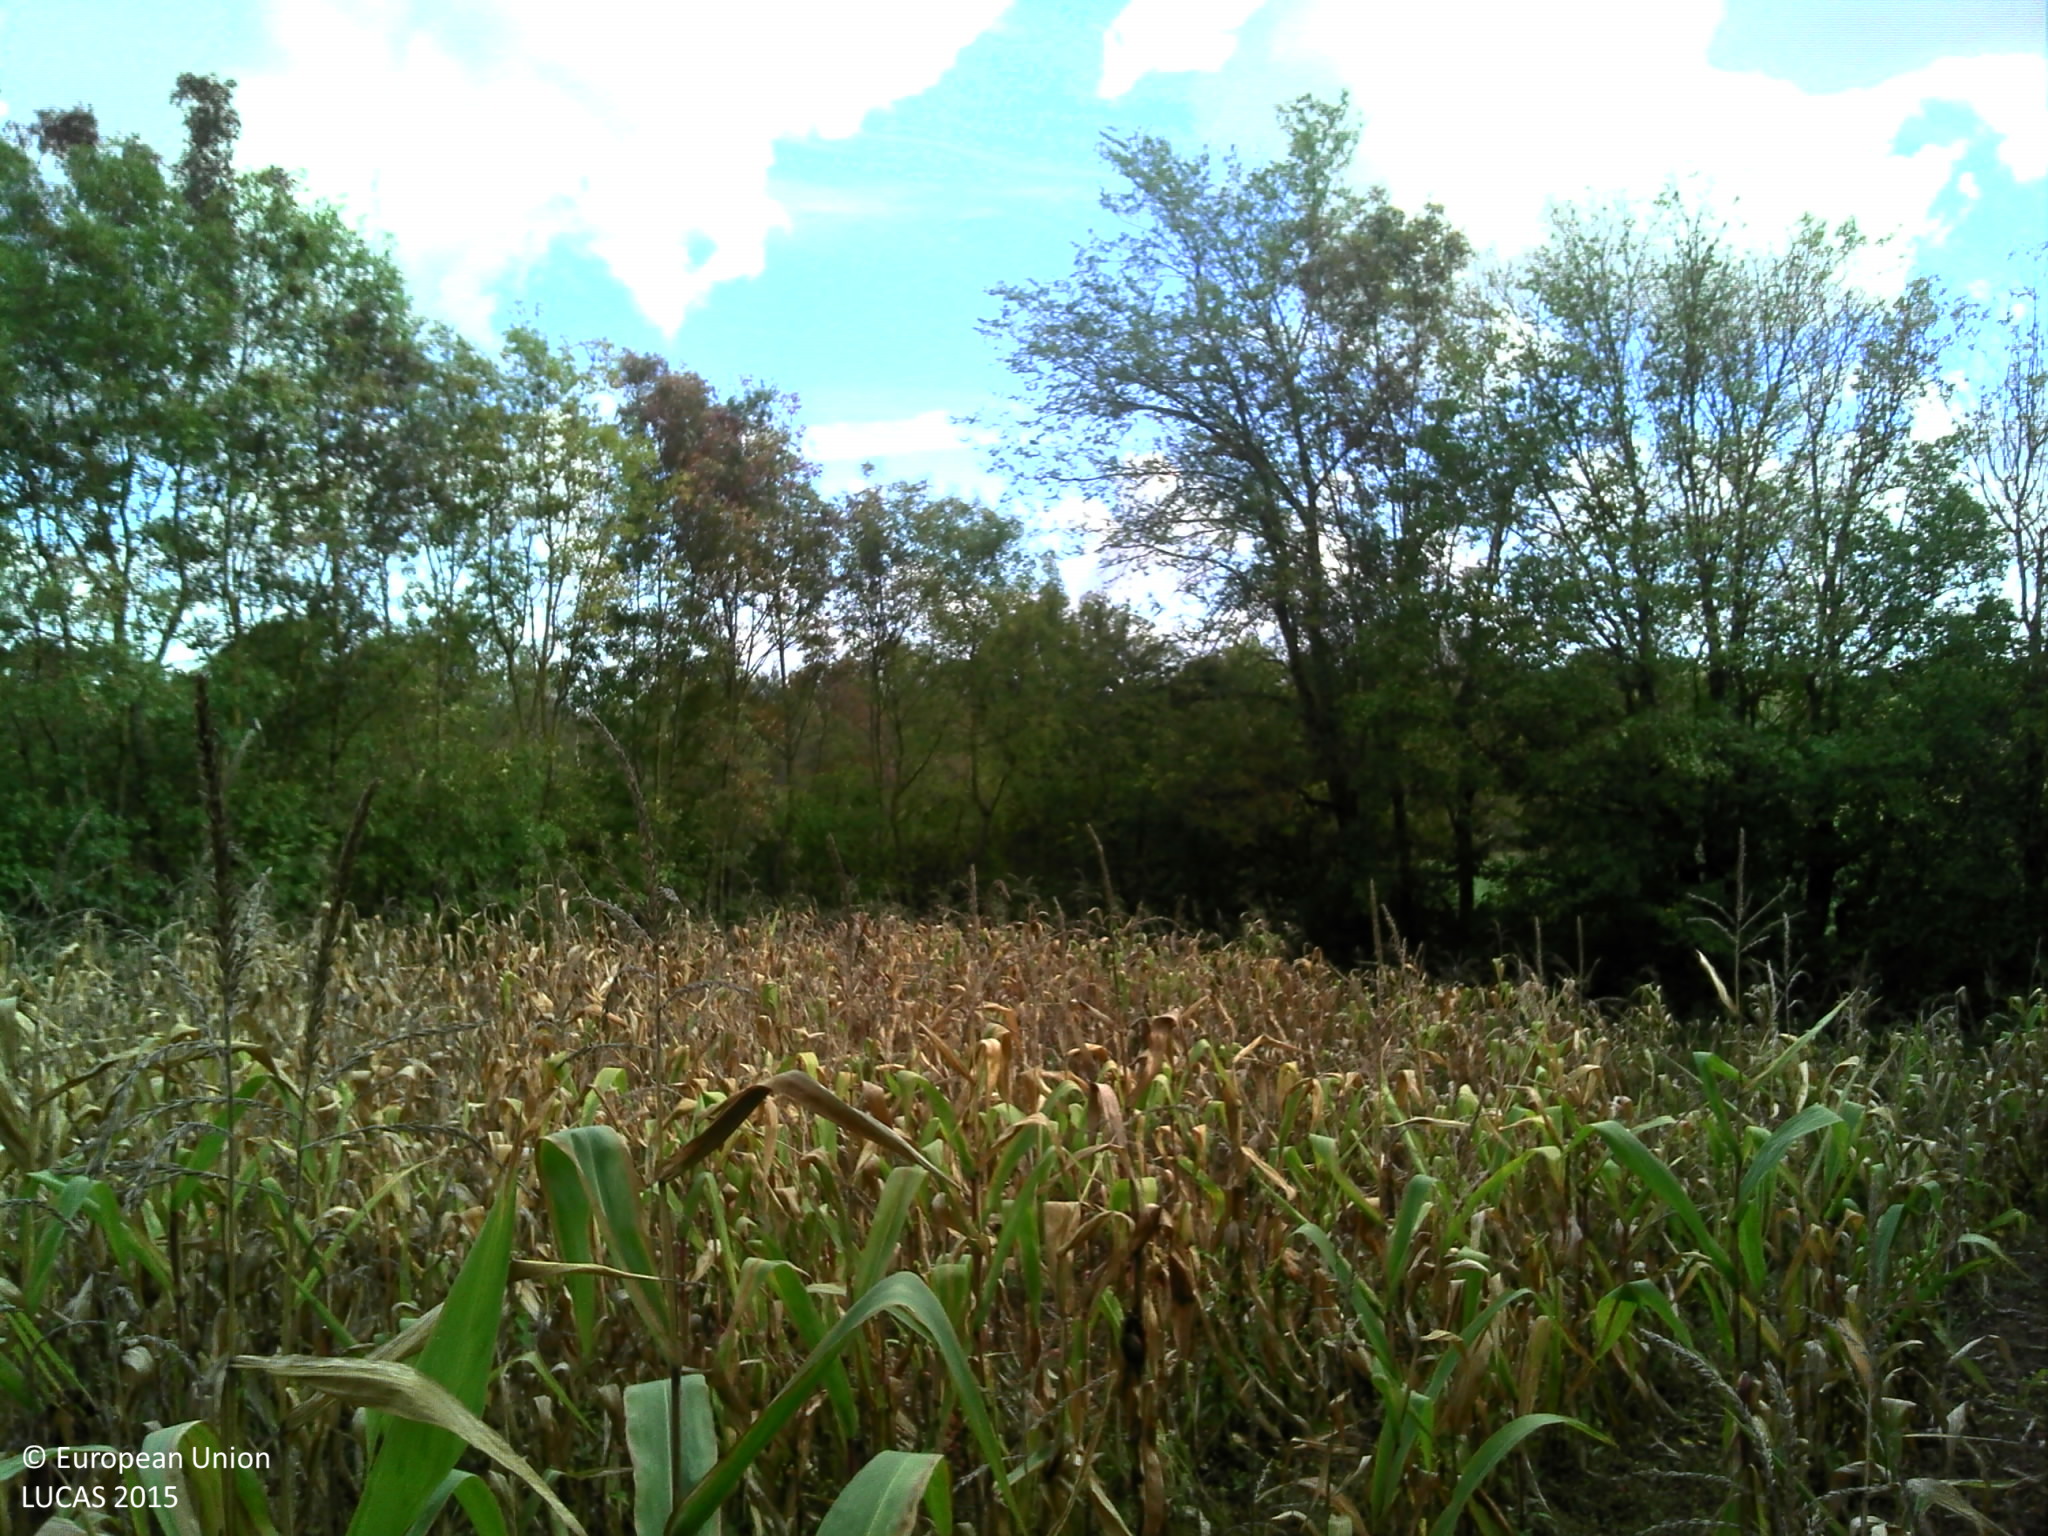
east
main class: Cropland
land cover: Maize
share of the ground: > 75 %
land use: Agriculture (excluding fallow land and kitchen gardens)
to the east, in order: Maize; Abandoned hedges; Fences; Grassland without tree/shrub cover; Managed hedges; Ditches and canals; Fences; Grassland without tree/shrub cover
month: October
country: FR
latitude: 46.3642
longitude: 5.0763
